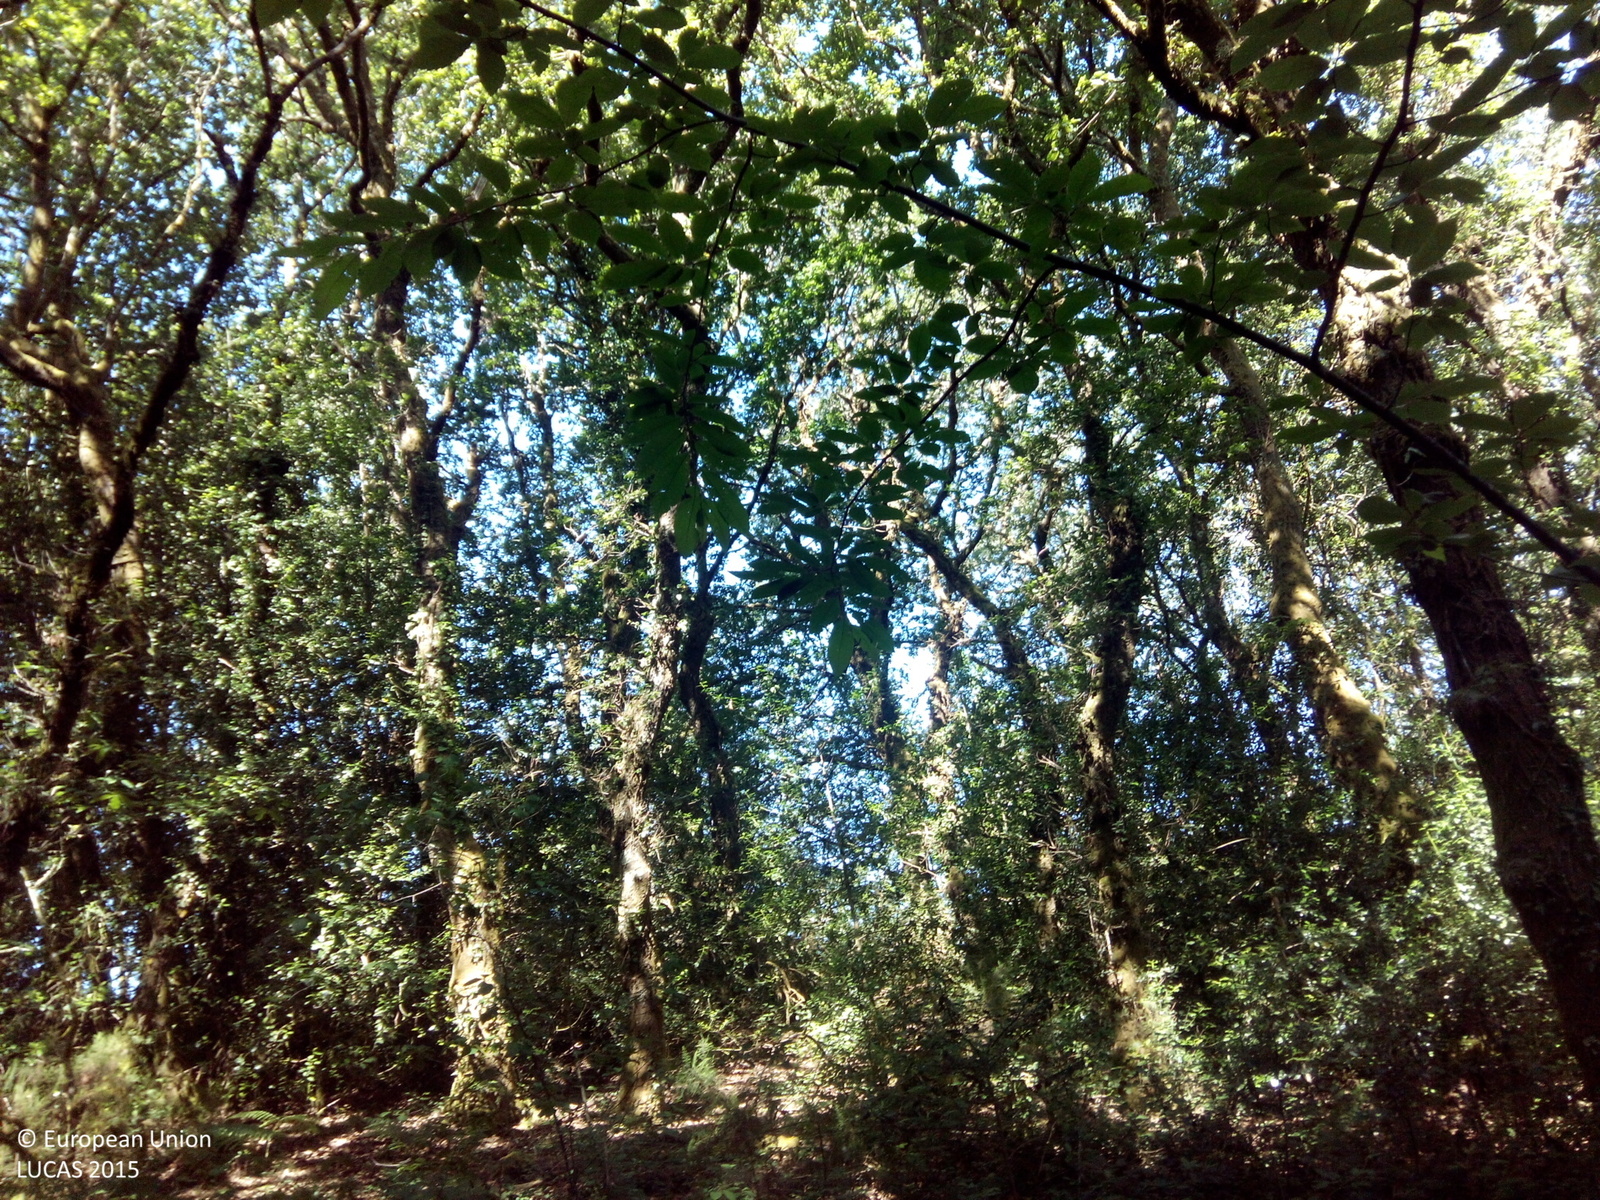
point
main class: Woodland
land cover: Broadleaved woodland
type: acidophilous oak and oak-birch forest
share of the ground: > 75 %
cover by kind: broadleaved forest trees 100 %
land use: Forestry
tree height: > 5 m
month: June
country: ES
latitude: 42.5186
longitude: -8.3145
